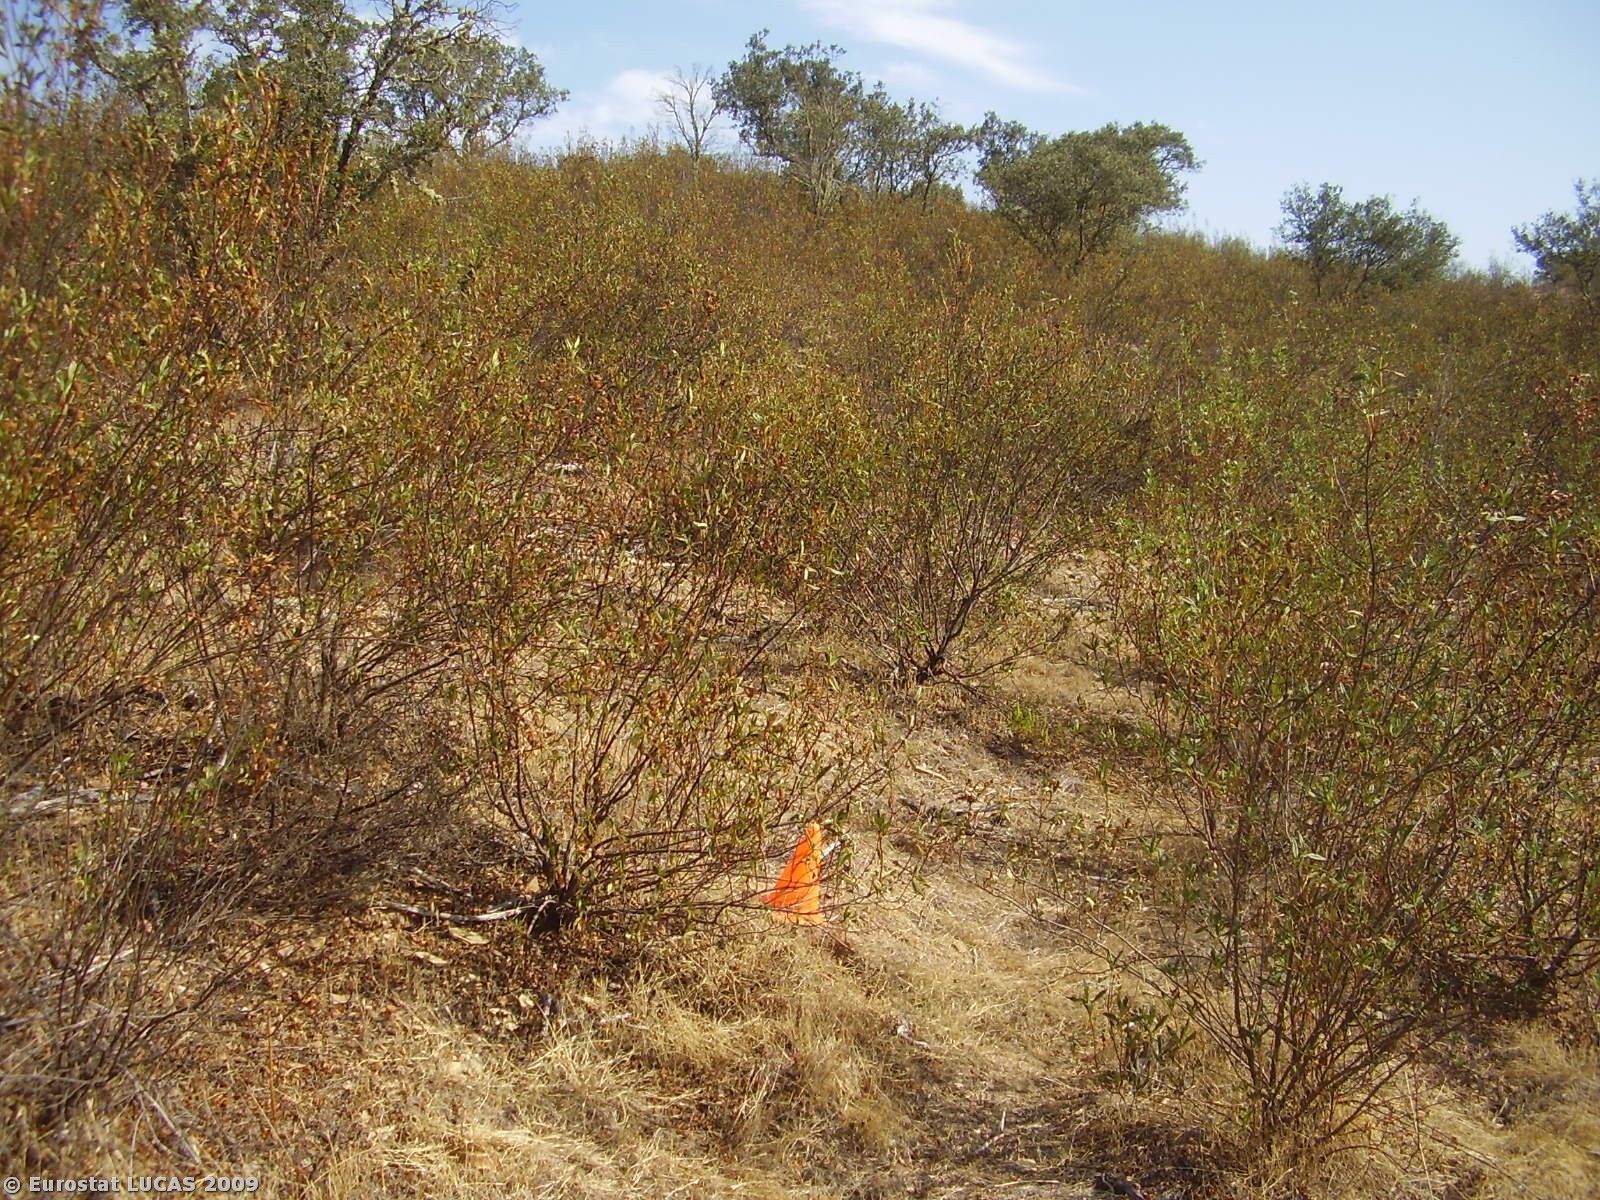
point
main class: Shrubland
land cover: Shrubland with sparse tree cover
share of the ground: 50 - 75 %
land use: Forestry
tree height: > 5 m
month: August
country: PT
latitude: 37.5598
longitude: -8.2422
